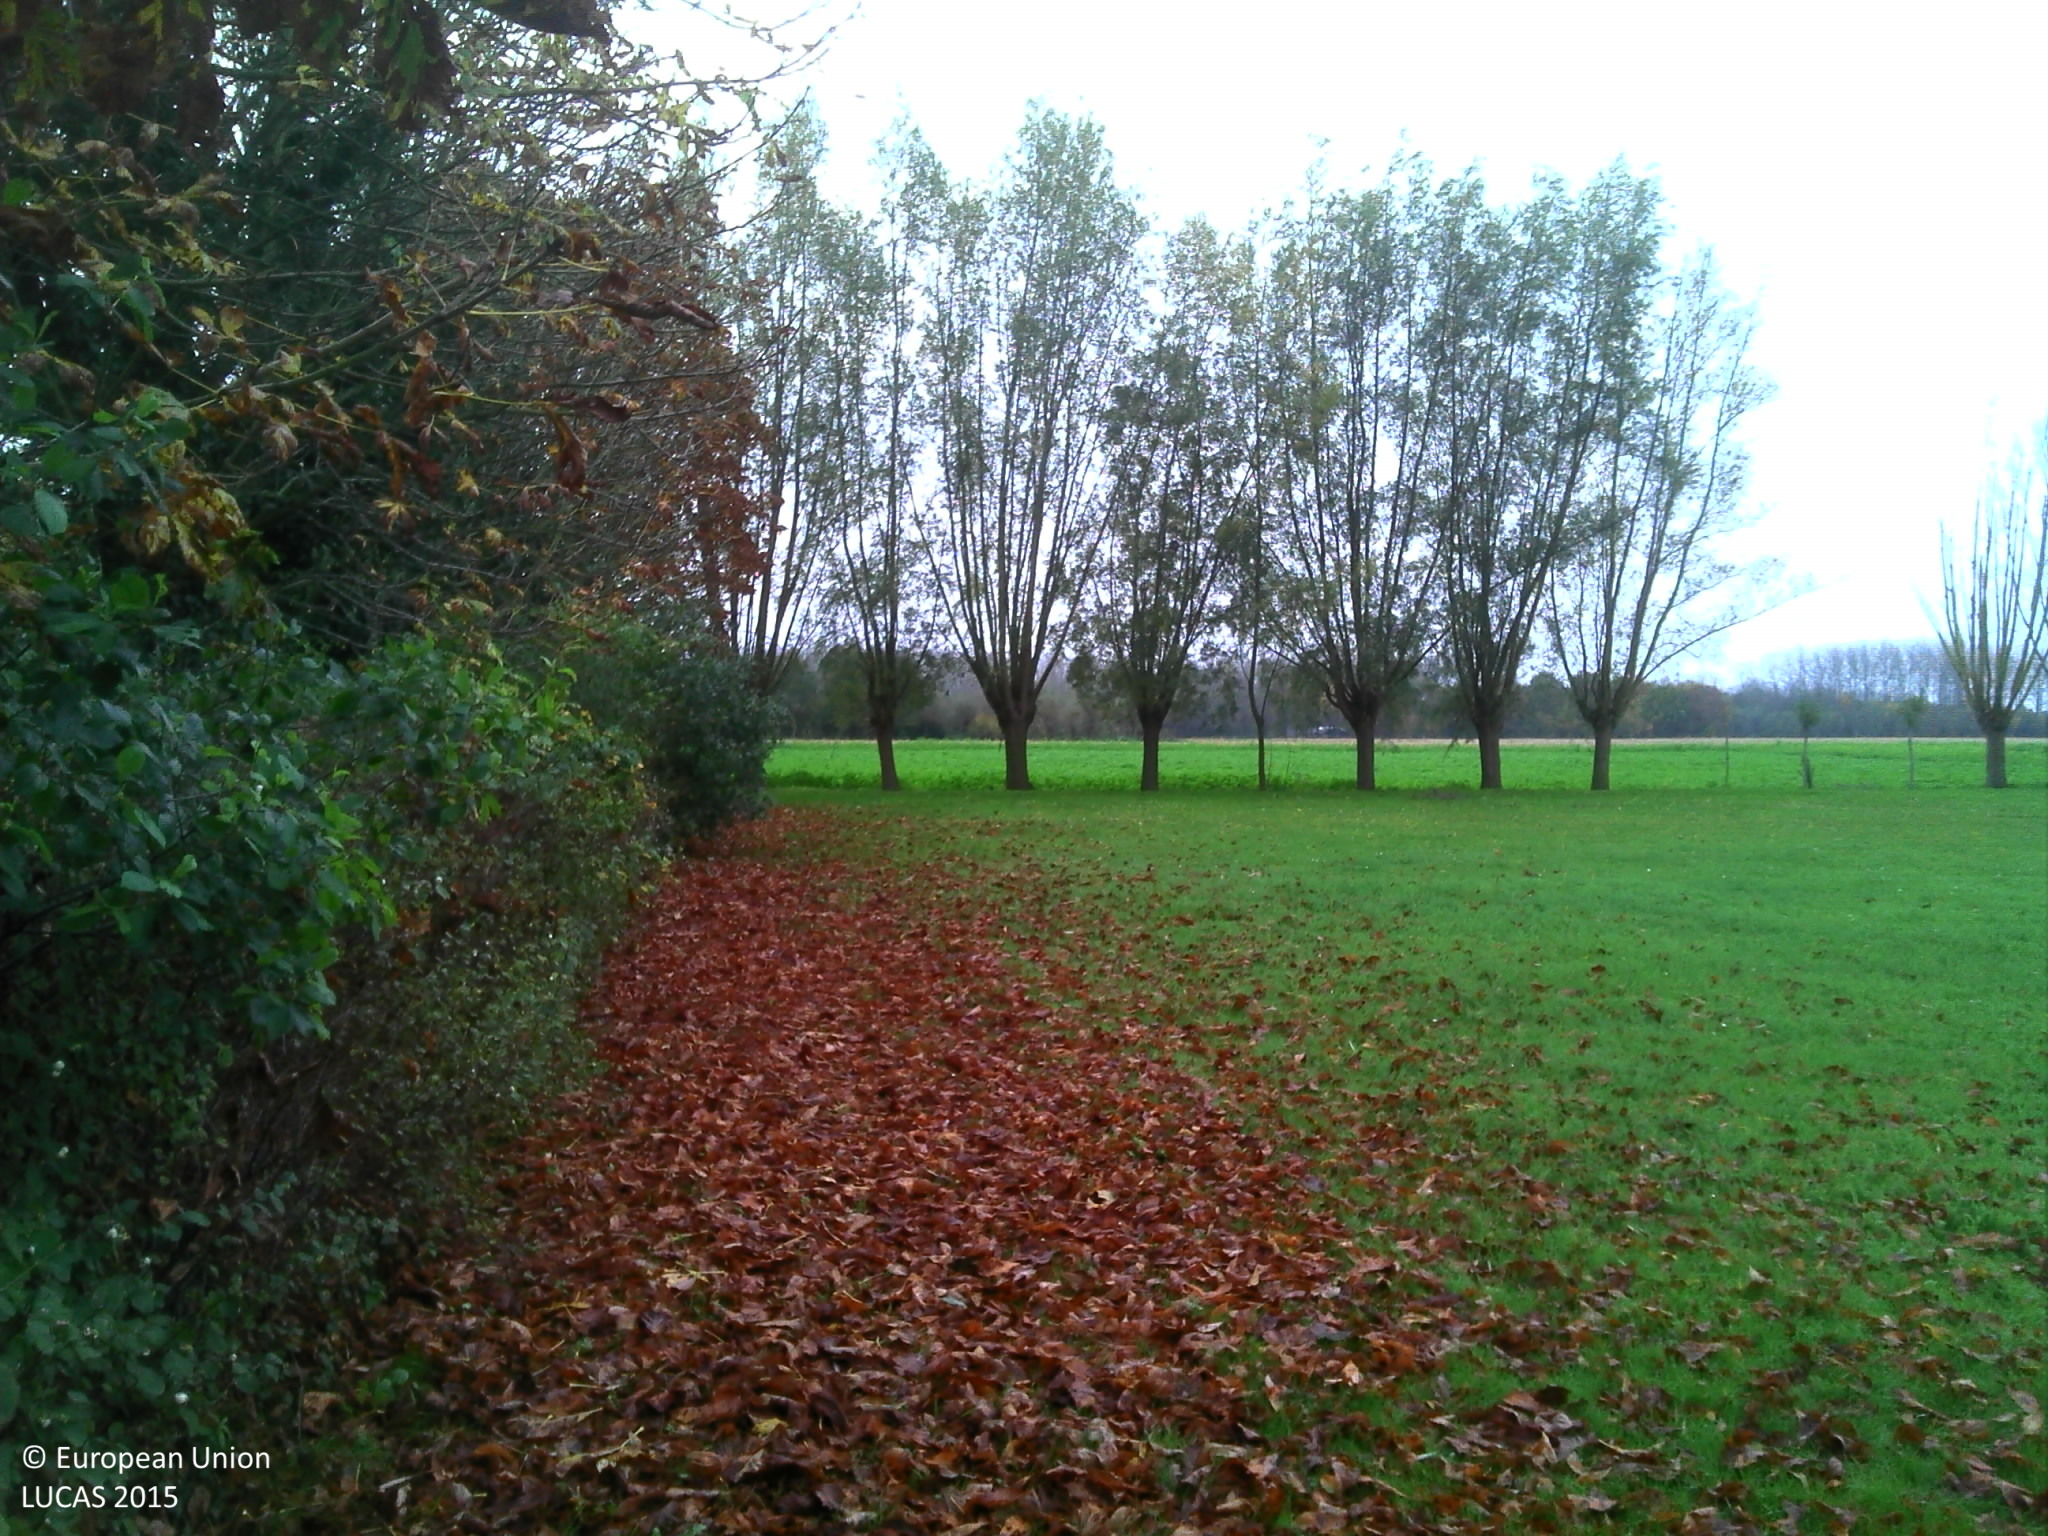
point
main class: Grassland
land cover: Grassland without tree/shrub cover
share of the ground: > 75 %
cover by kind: herbaceous plants 100 %
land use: Residential
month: November
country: BE
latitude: 51.1050
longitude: 4.2966
